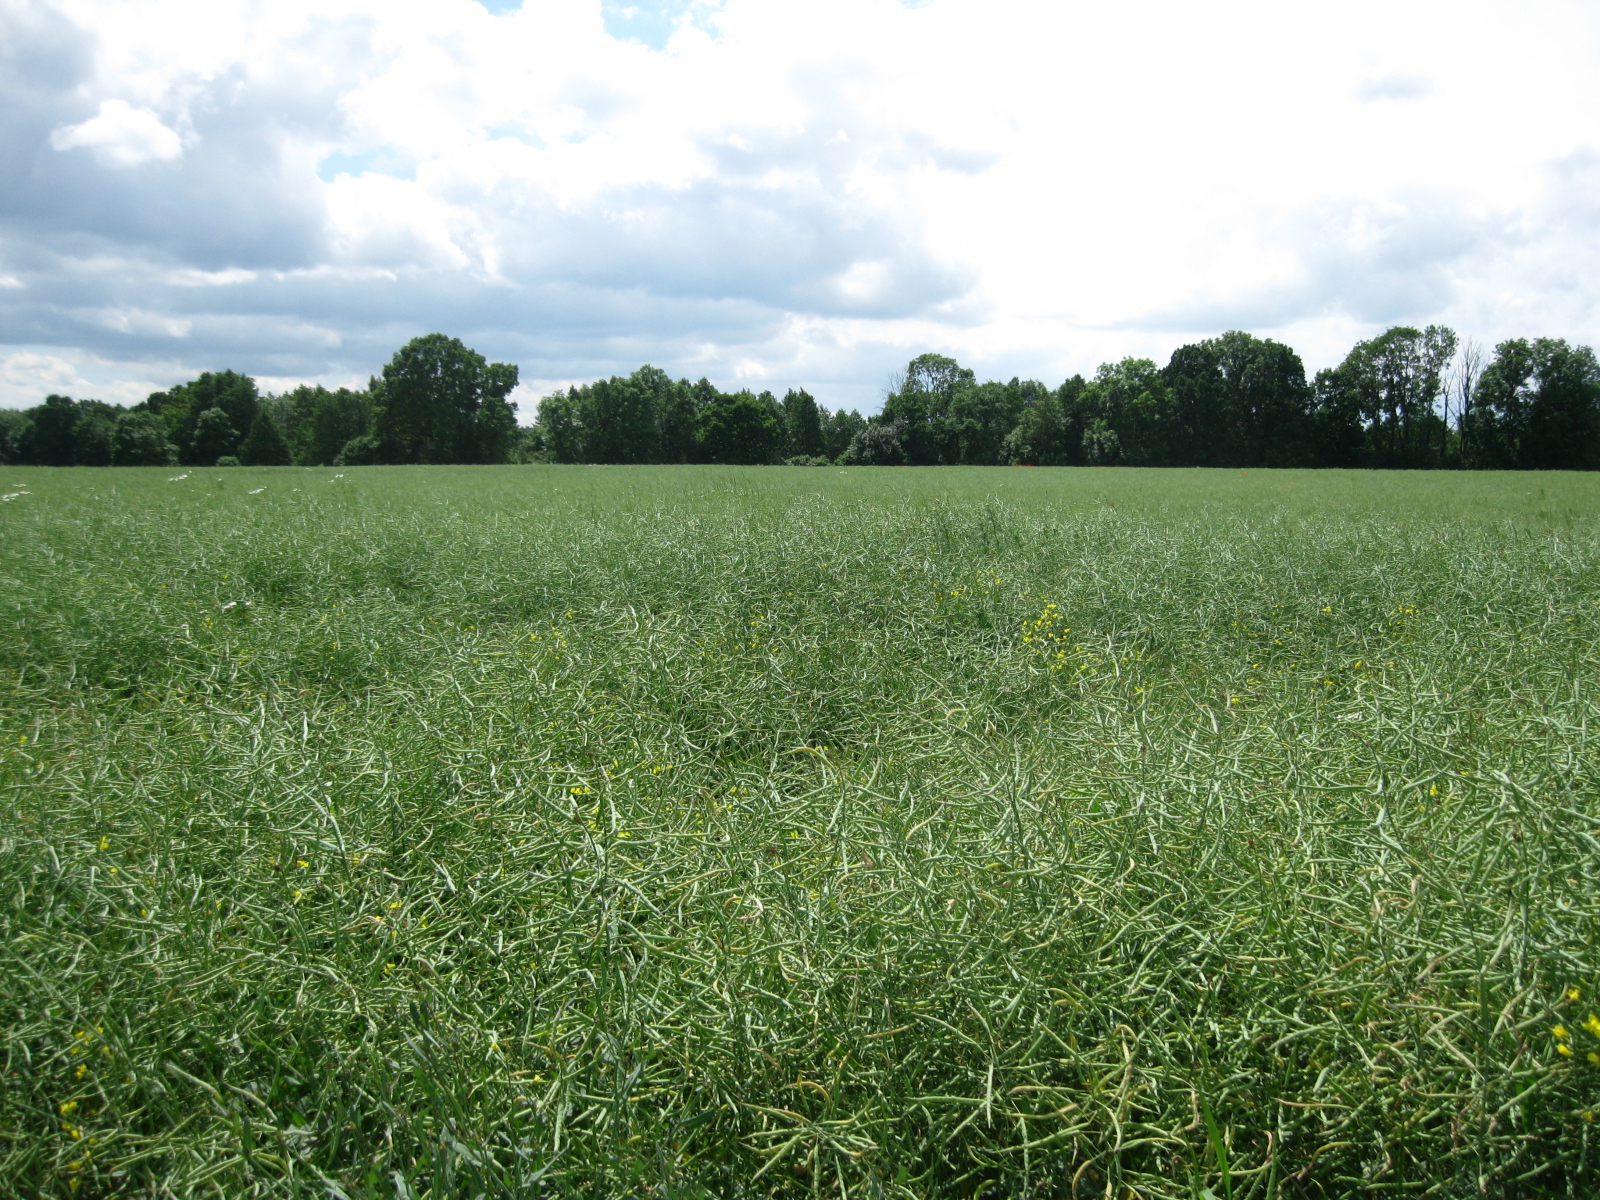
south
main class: Cropland
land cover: Rape and turnip rape
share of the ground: > 75 %
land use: Agriculture (excluding fallow land and kitchen gardens)
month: June
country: LT
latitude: 55.5760
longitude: 24.1937
